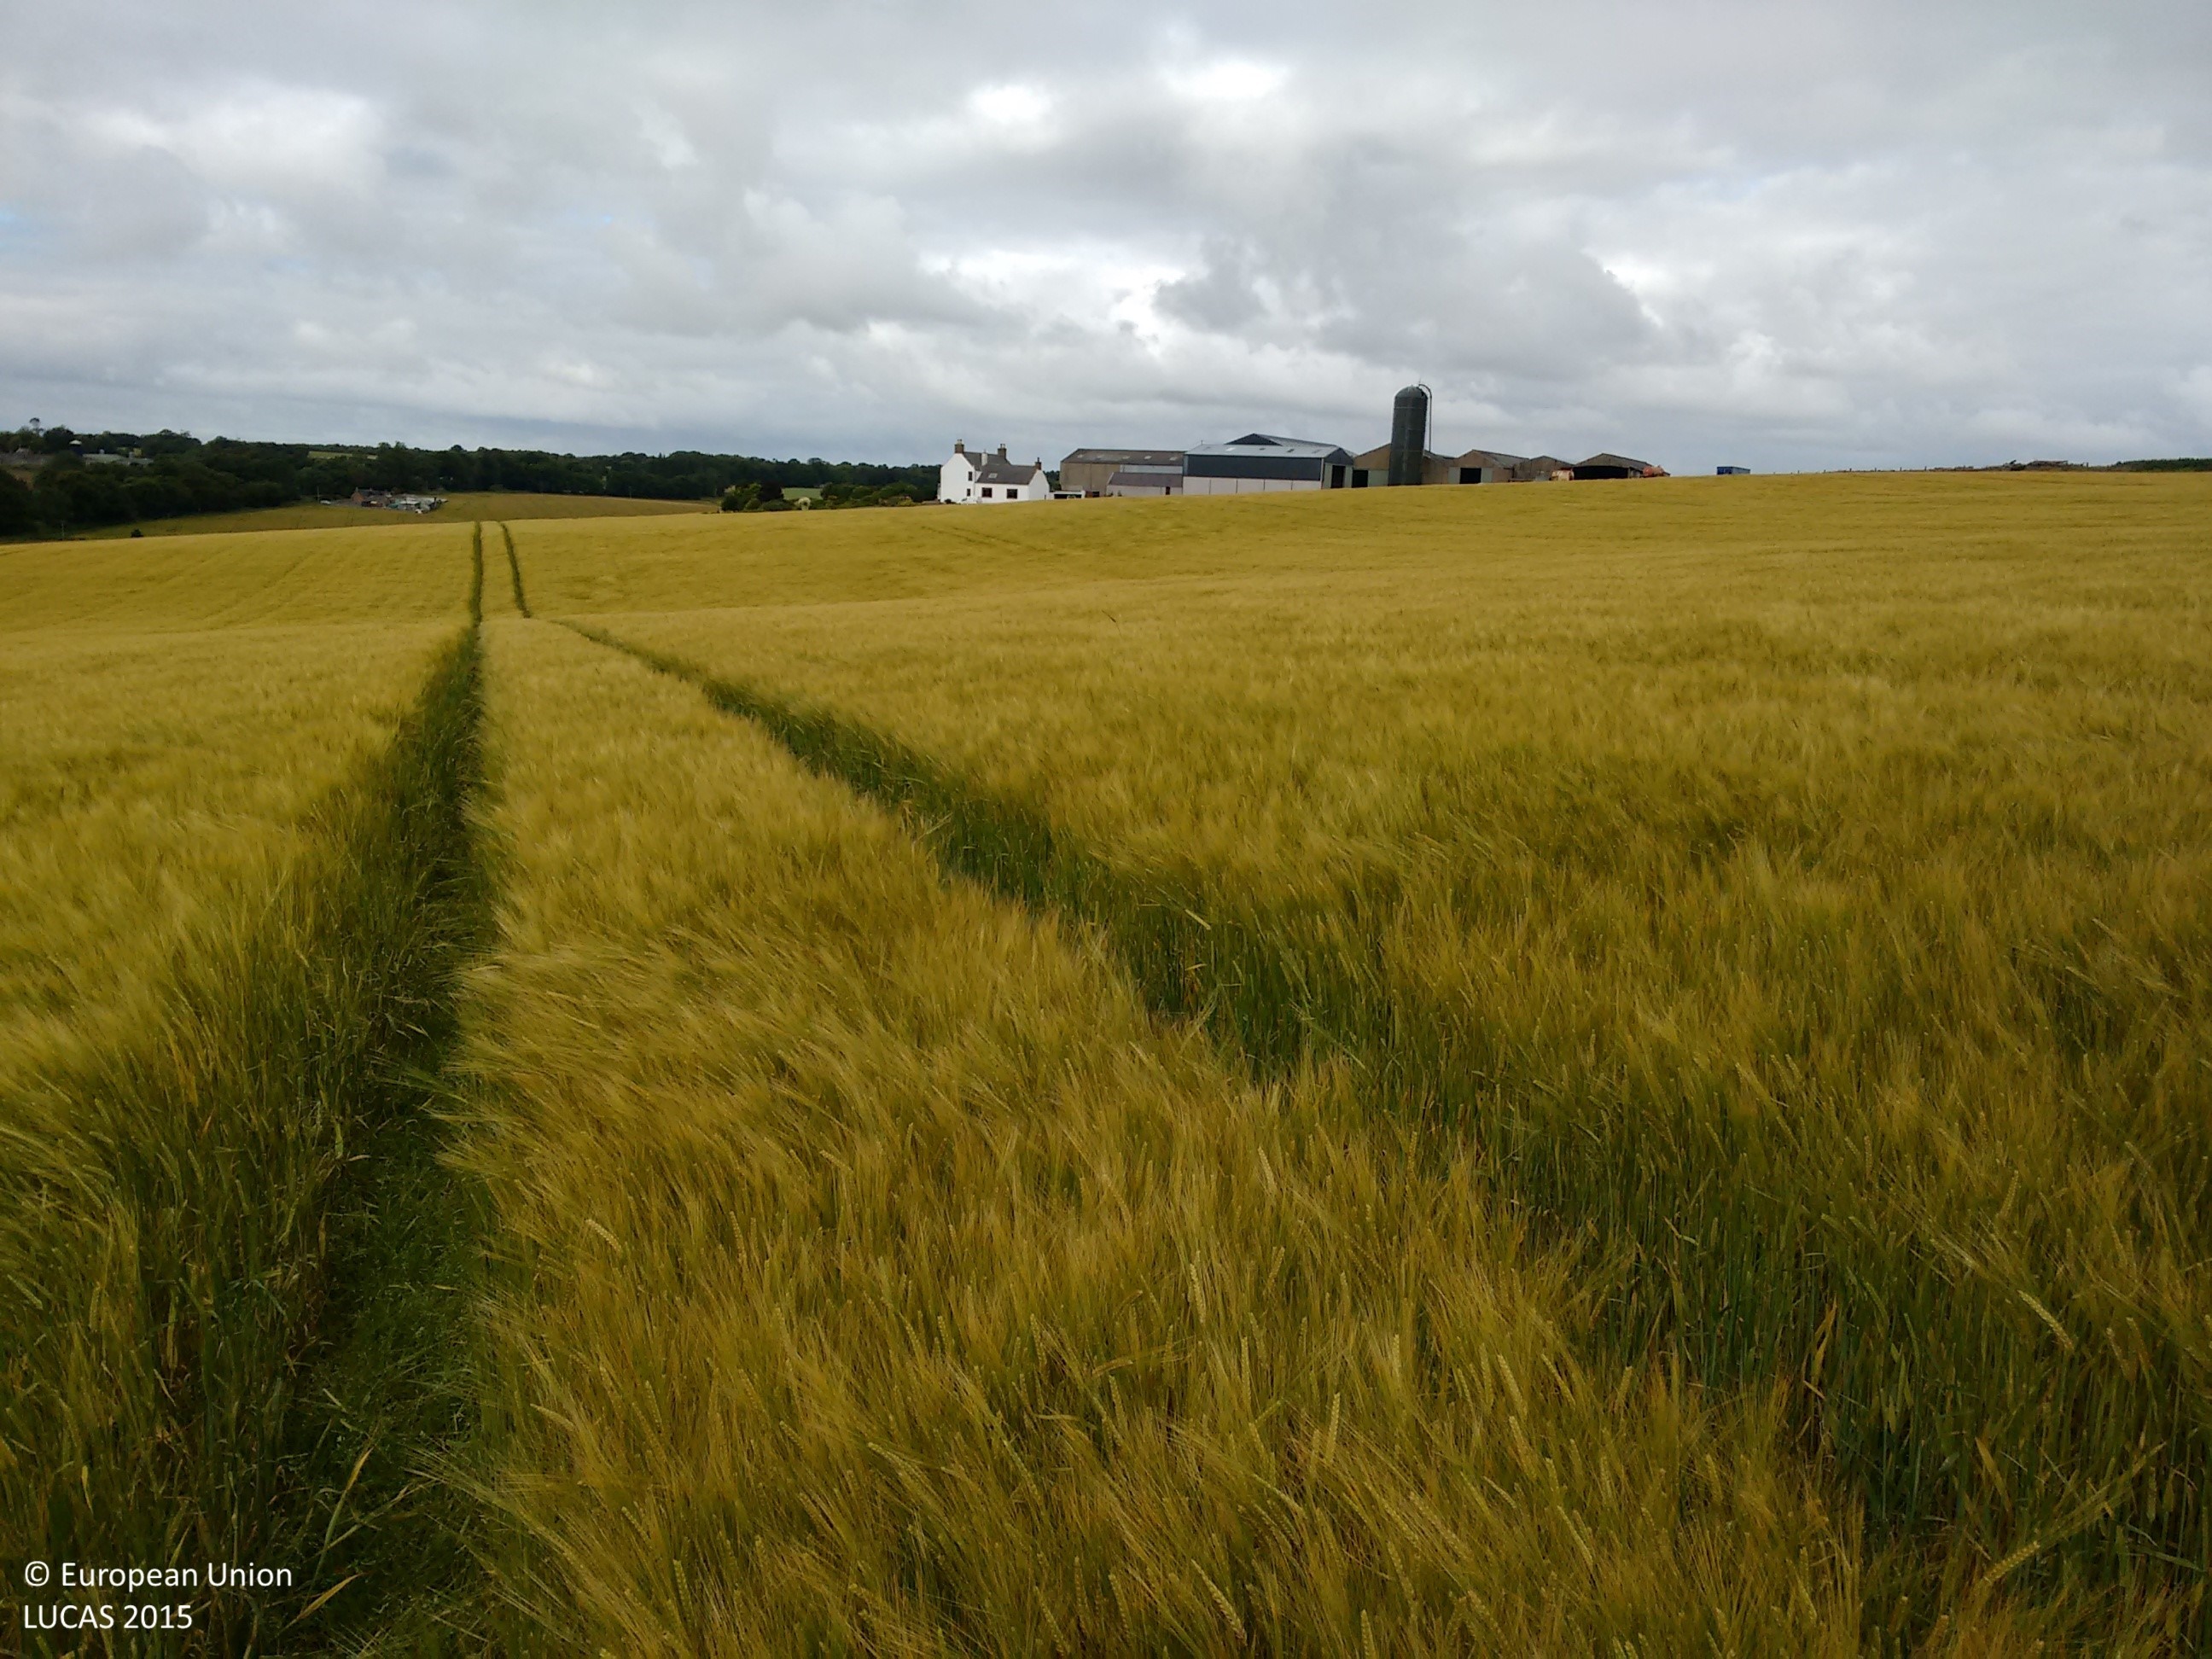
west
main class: Cropland
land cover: Barley
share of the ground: > 75 %
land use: Agriculture (excluding fallow land and kitchen gardens)
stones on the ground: 10 - 25 %
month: July
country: GB
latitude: 57.5513
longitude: -2.4001
